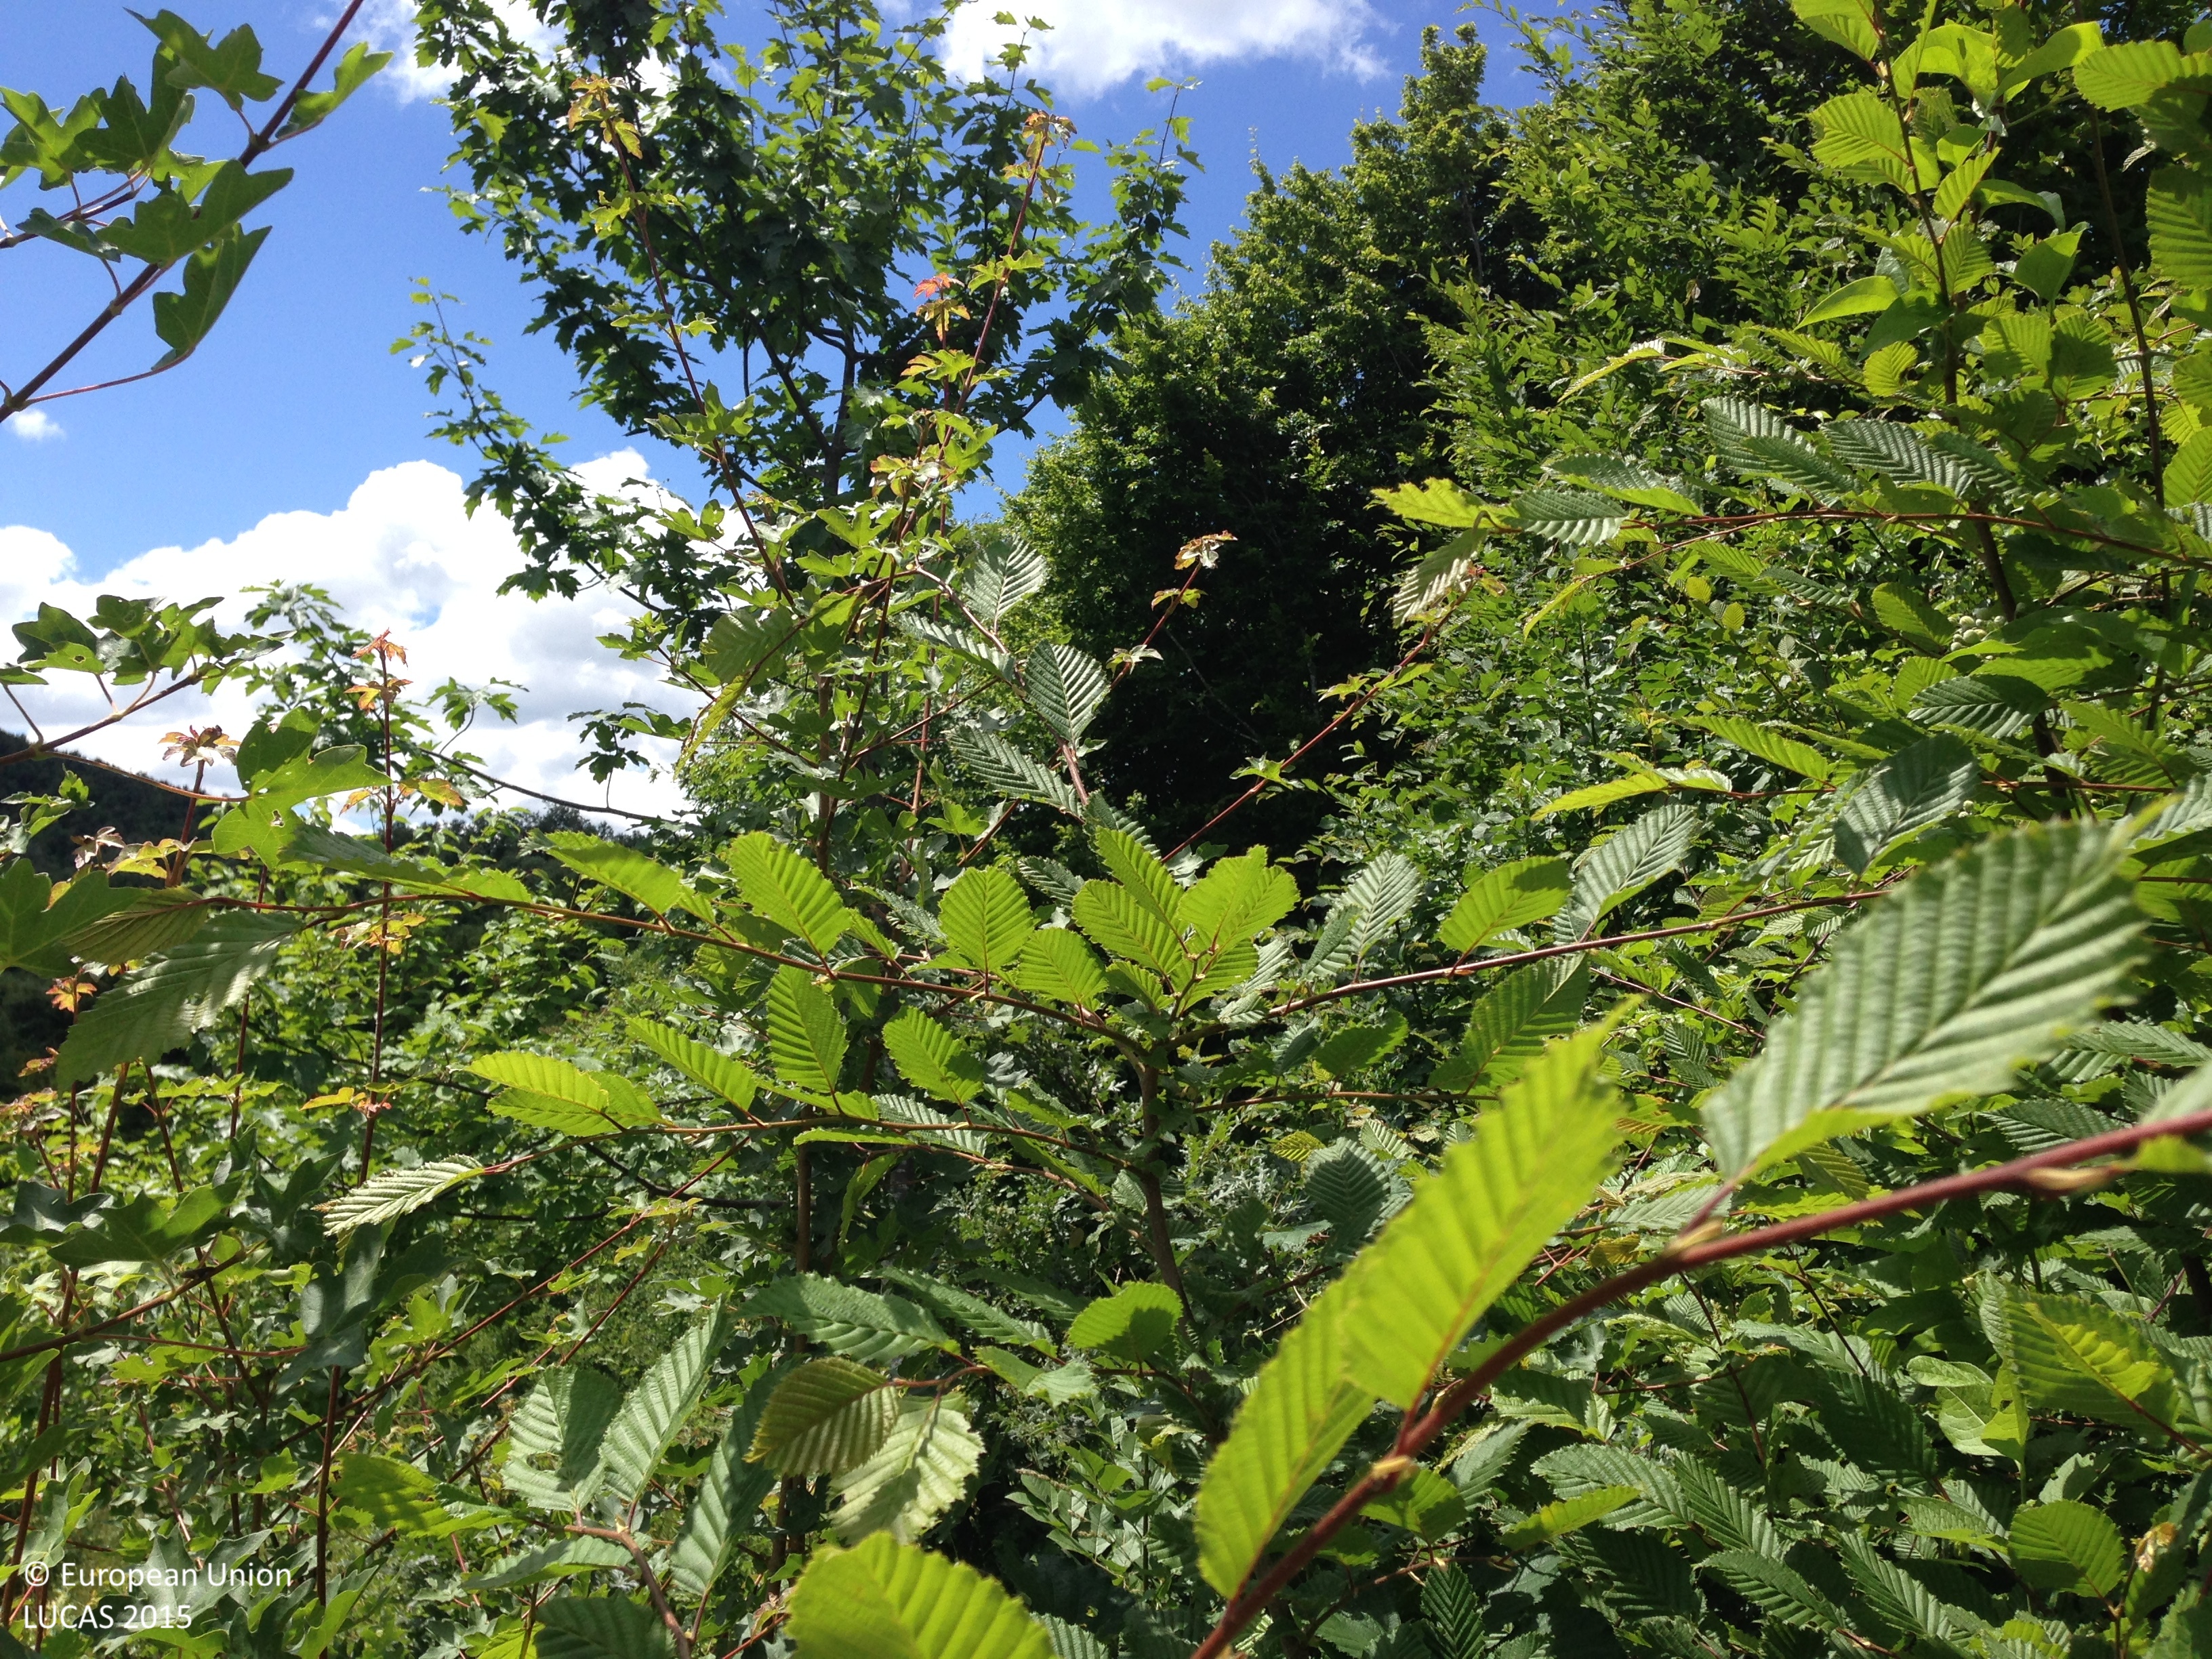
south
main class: Woodland
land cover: Broadleaved woodland
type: thermophilous deciduous forest
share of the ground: 10 - 25 %
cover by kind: herbaceous plants 50 %, shrubs 30 %, broadleaved forest trees 15 %, unconsolidated bare surface 5 %
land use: Semi-natural and natural areas not in use
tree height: < 5 m
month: June
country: HR
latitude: 44.6479
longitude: 15.9836
